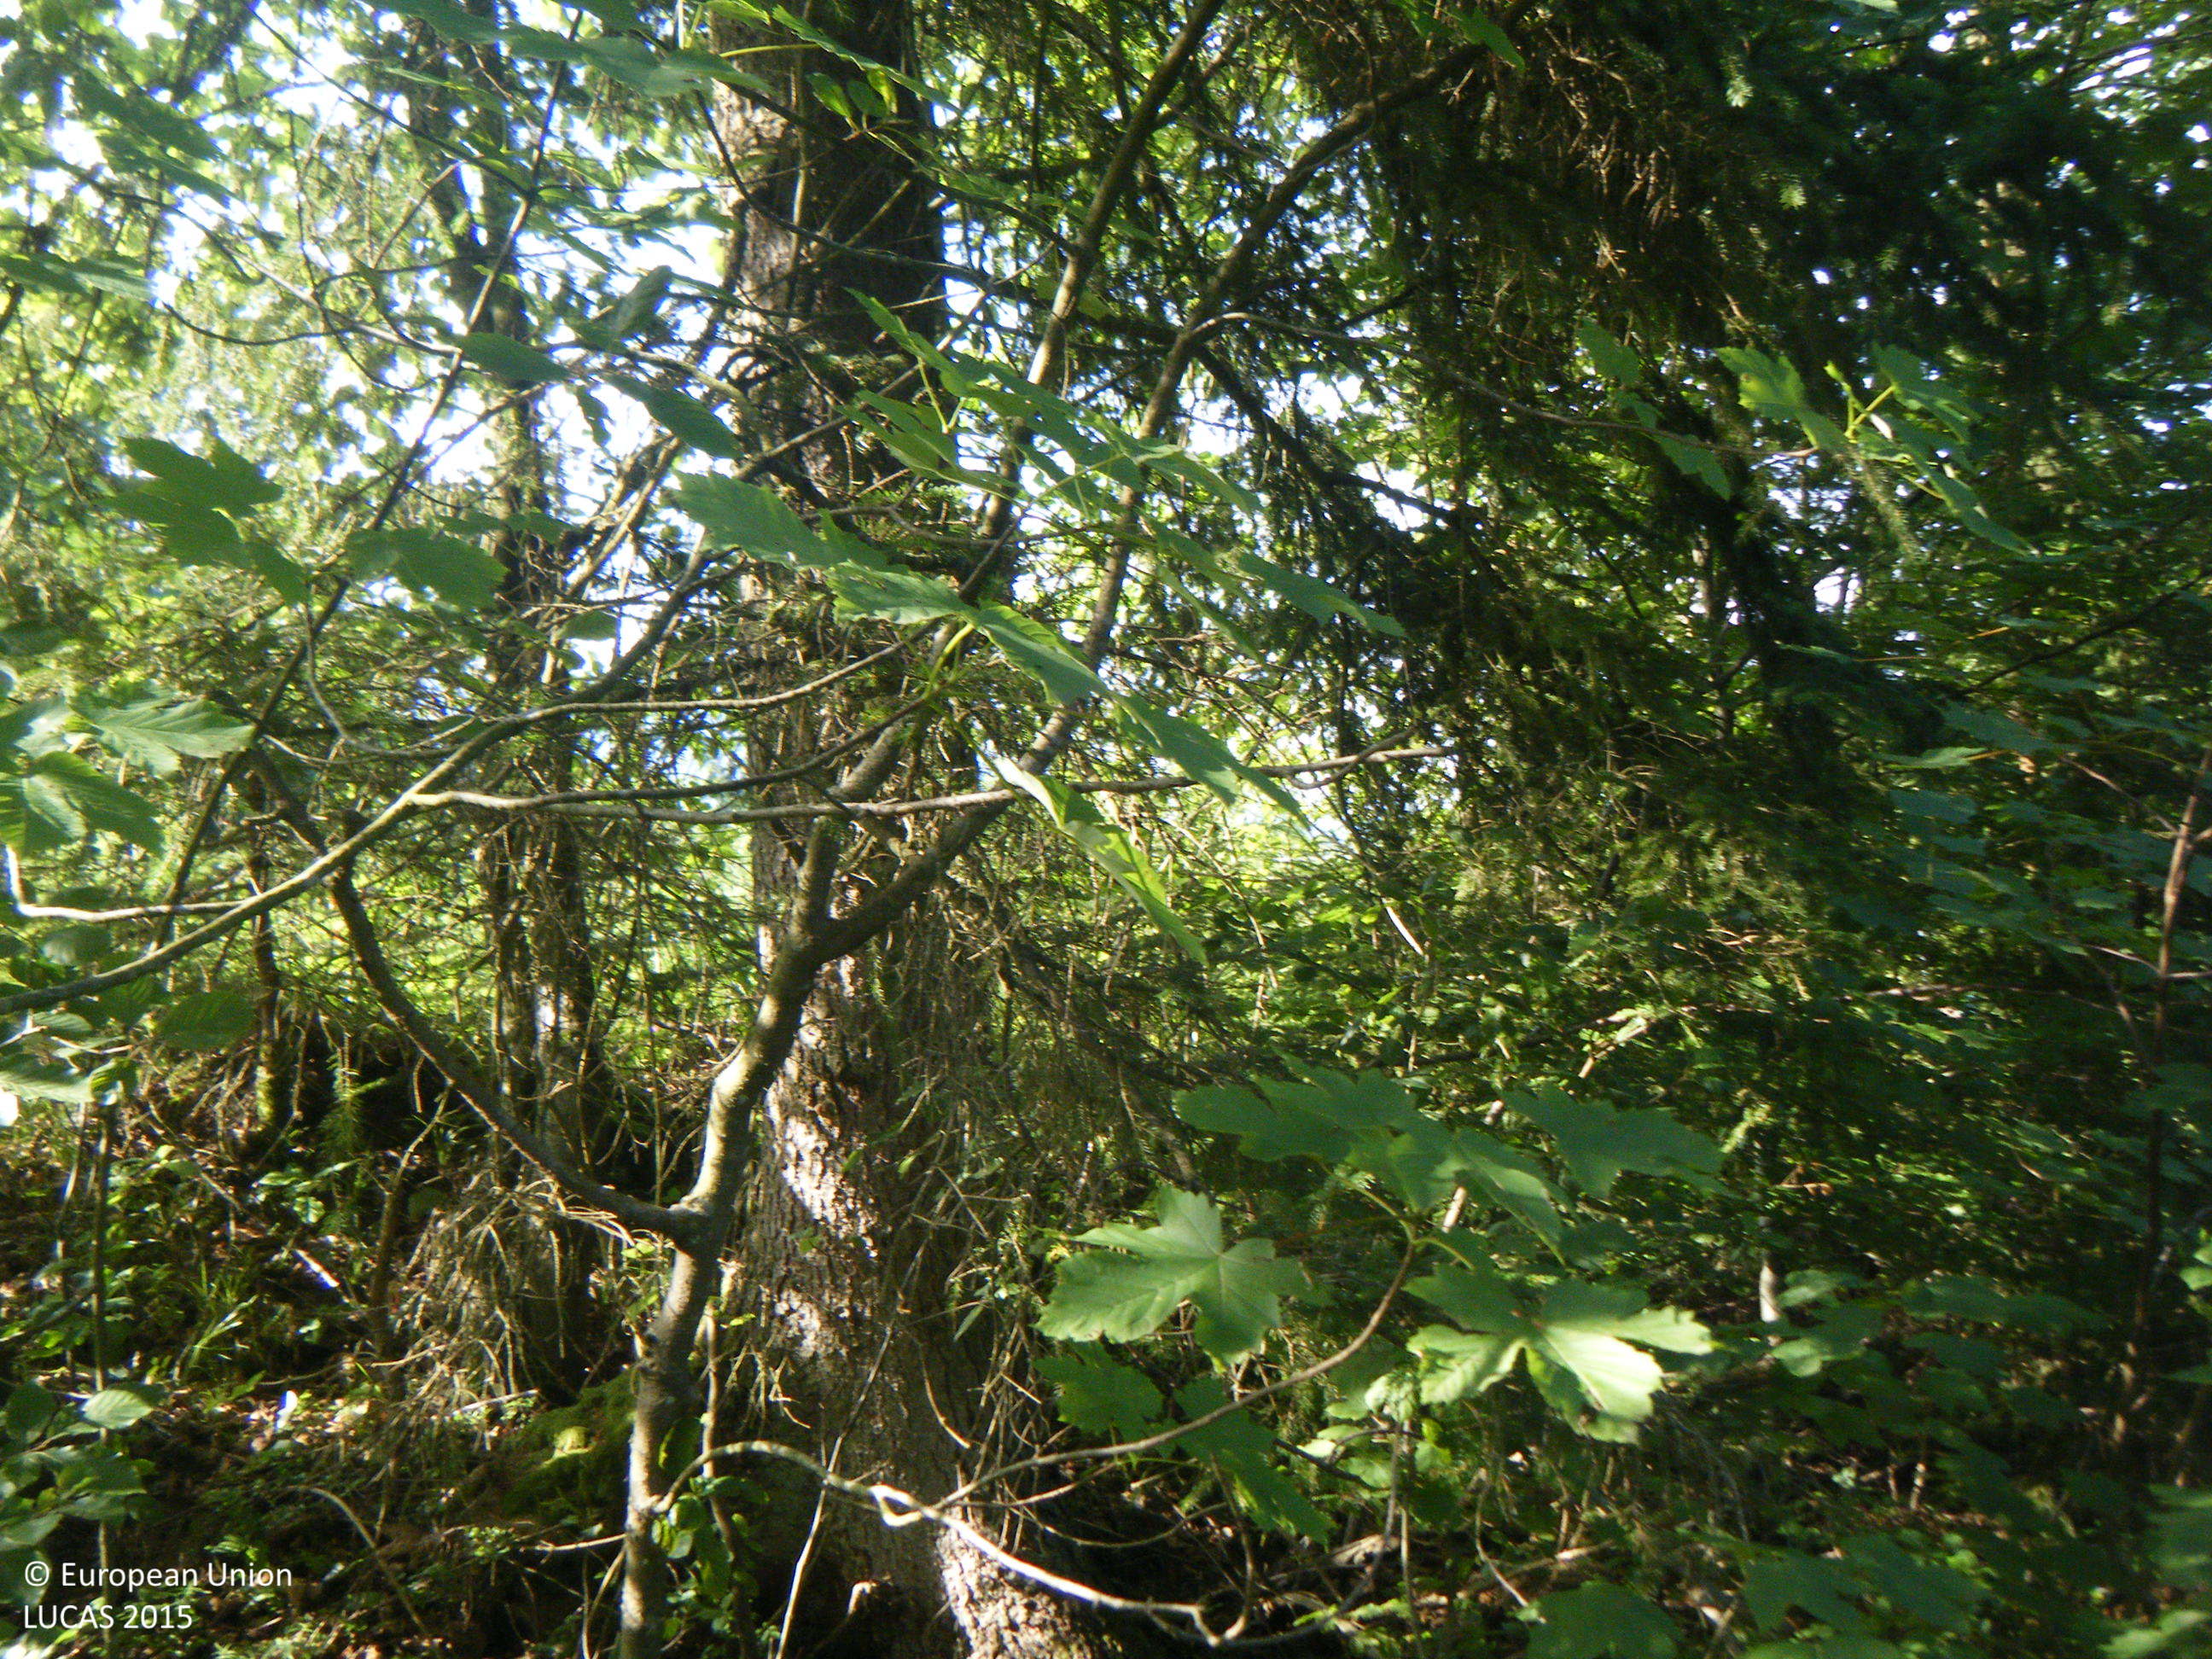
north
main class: Woodland
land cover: Spruce dominated mixed woodland
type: alpine coniferous forest
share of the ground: > 75 %
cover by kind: coniferous forest trees 70 %, broadleaved forest trees 25 %, shrubs 5 %
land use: Forestry
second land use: Sport
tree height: > 5 m
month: July
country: AT
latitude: 47.6242
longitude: 13.6047
